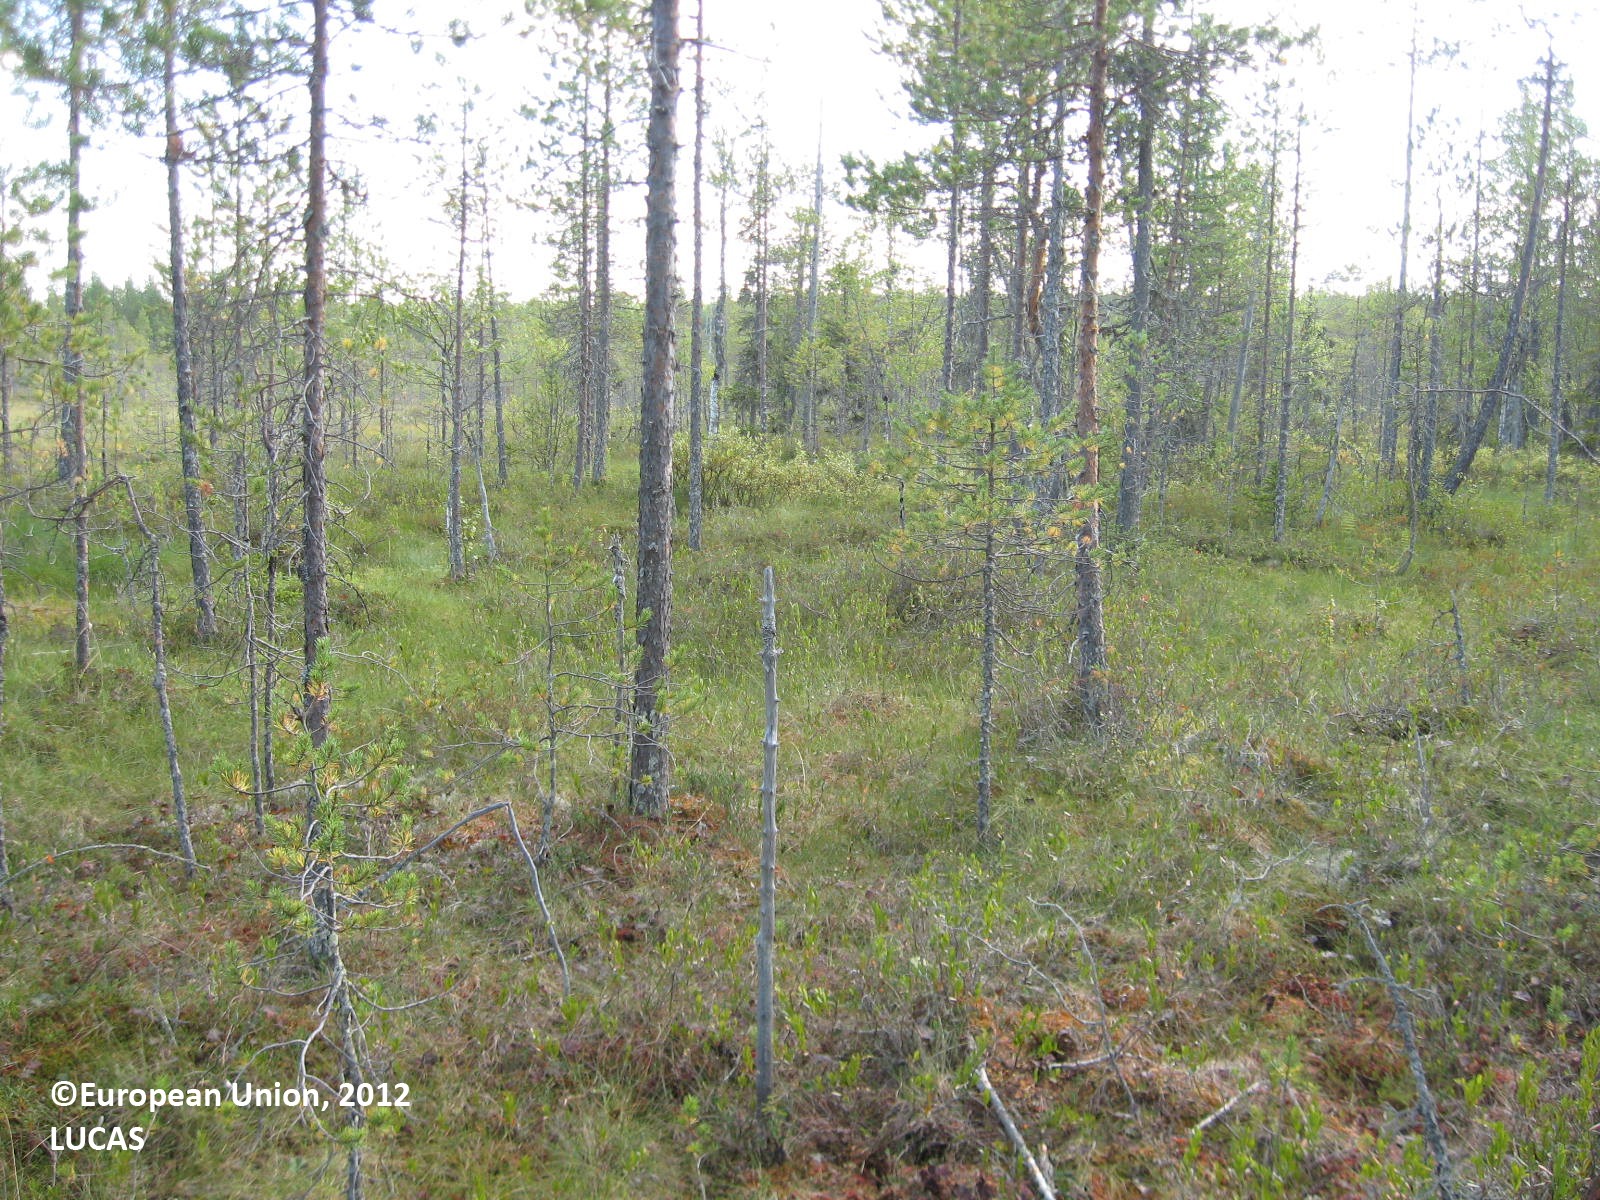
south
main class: Woodland
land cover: Pine dominated coniferous woodland
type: boreal forest
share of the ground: 50 - 75 %
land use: Forestry
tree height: > 5 m
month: August
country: FI
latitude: 63.7060
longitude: 29.9717
